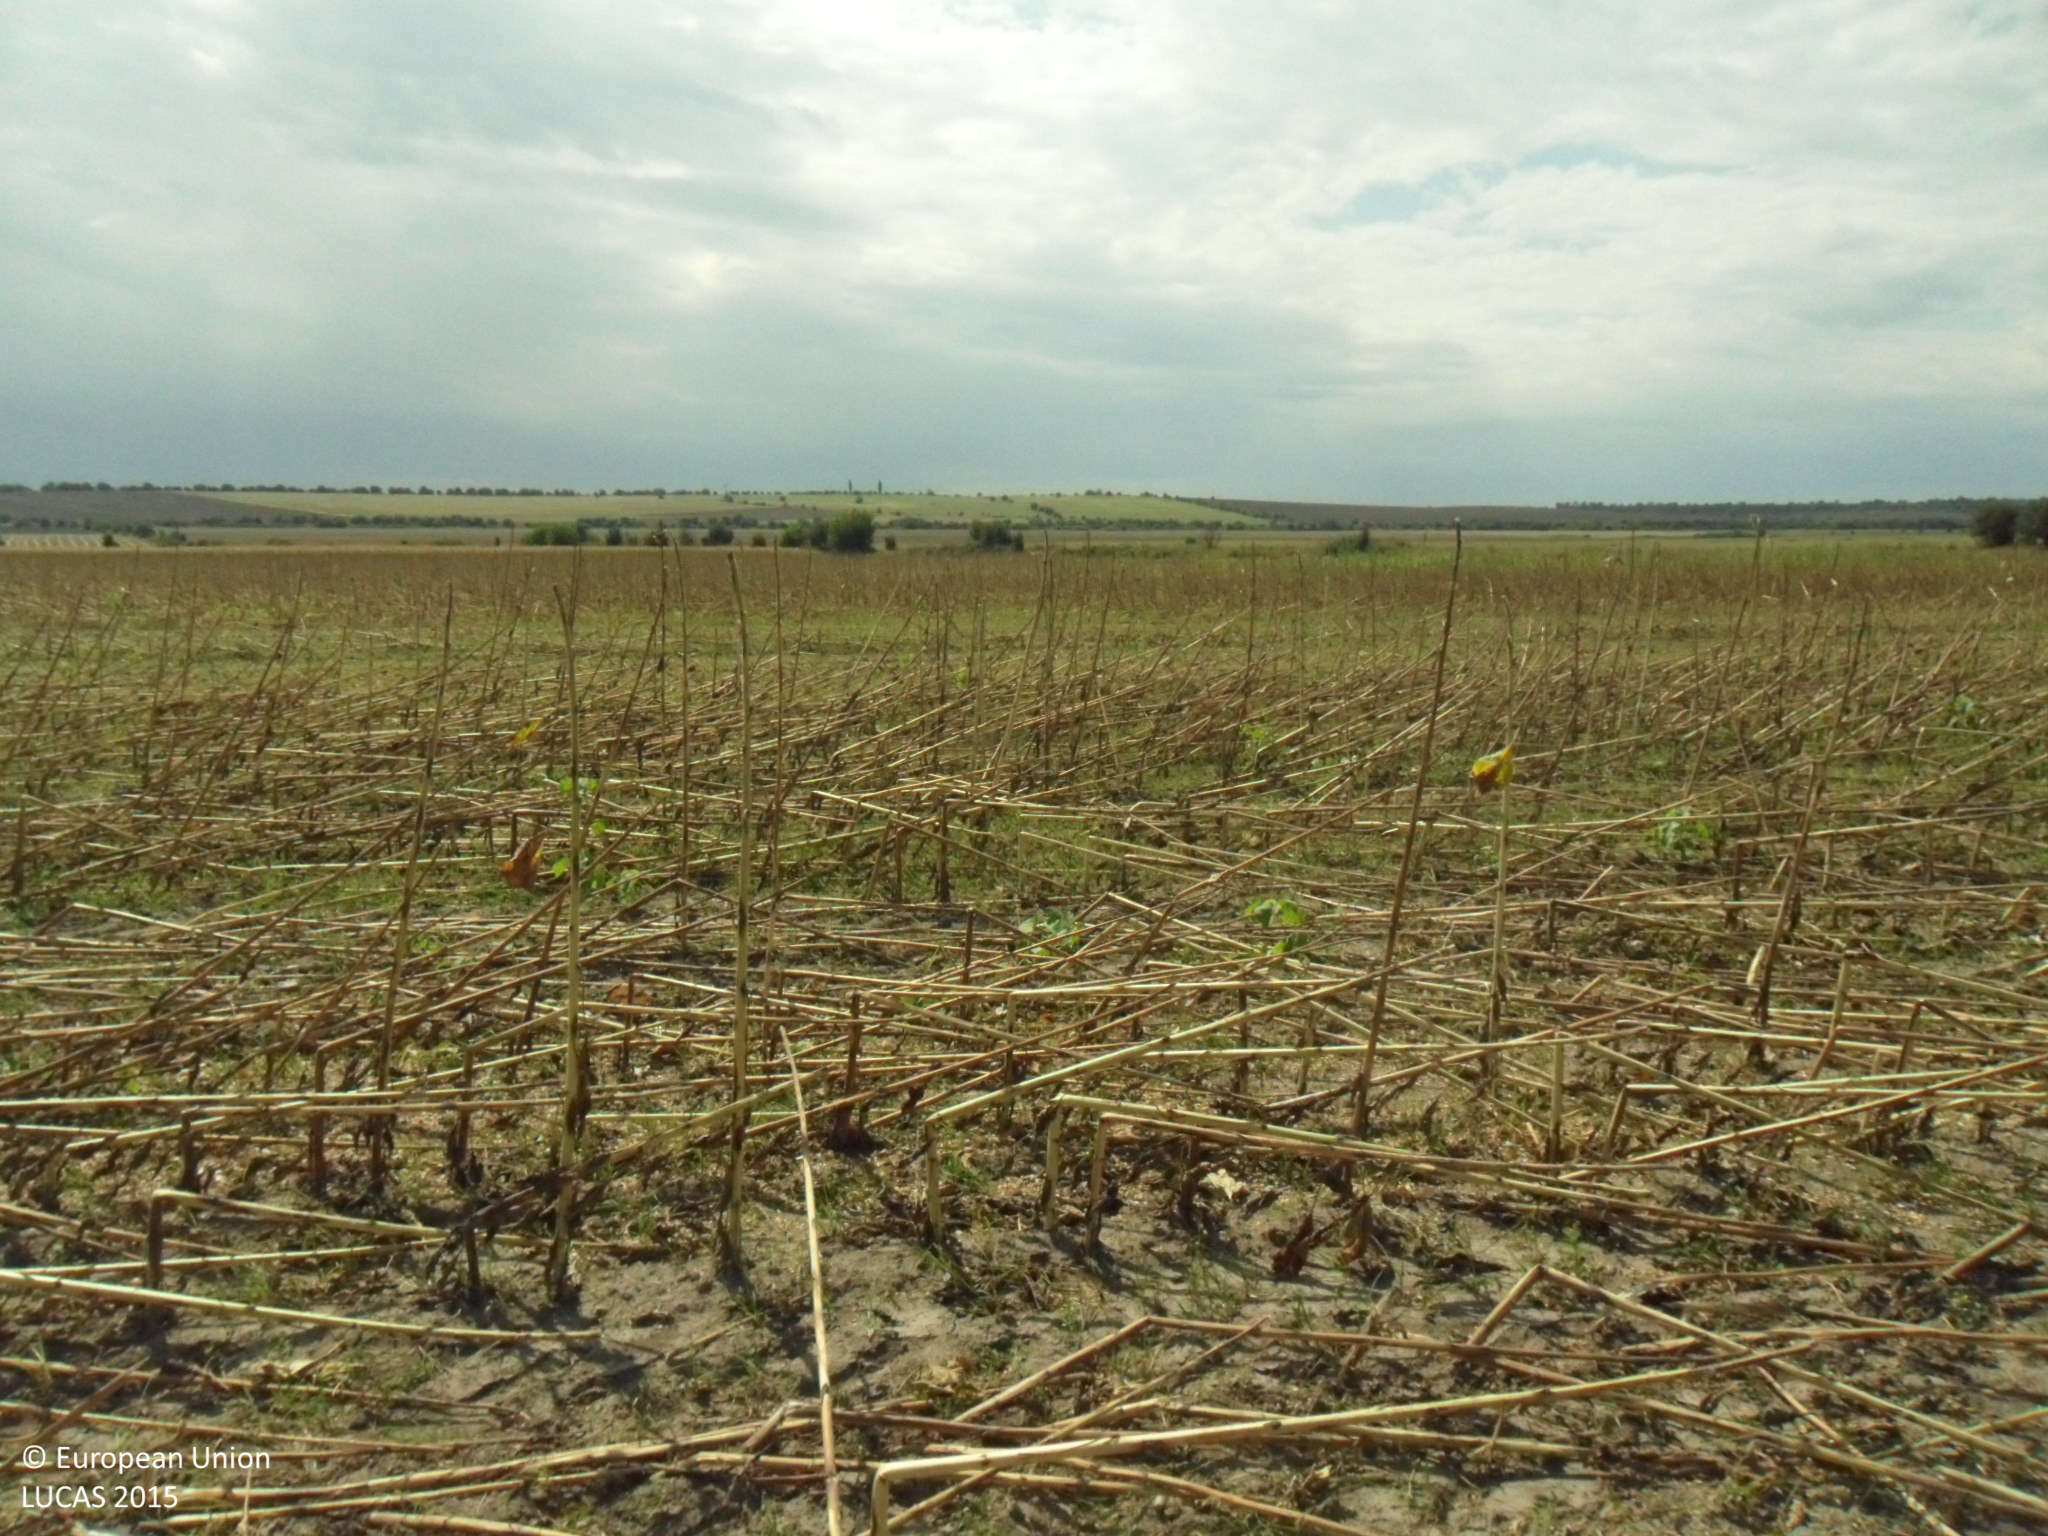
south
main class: Cropland
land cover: Sunflower
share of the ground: < 10 %
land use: Agriculture (excluding fallow land and kitchen gardens)
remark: Harvested field
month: September
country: BG
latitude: 43.9371
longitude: 26.3891
